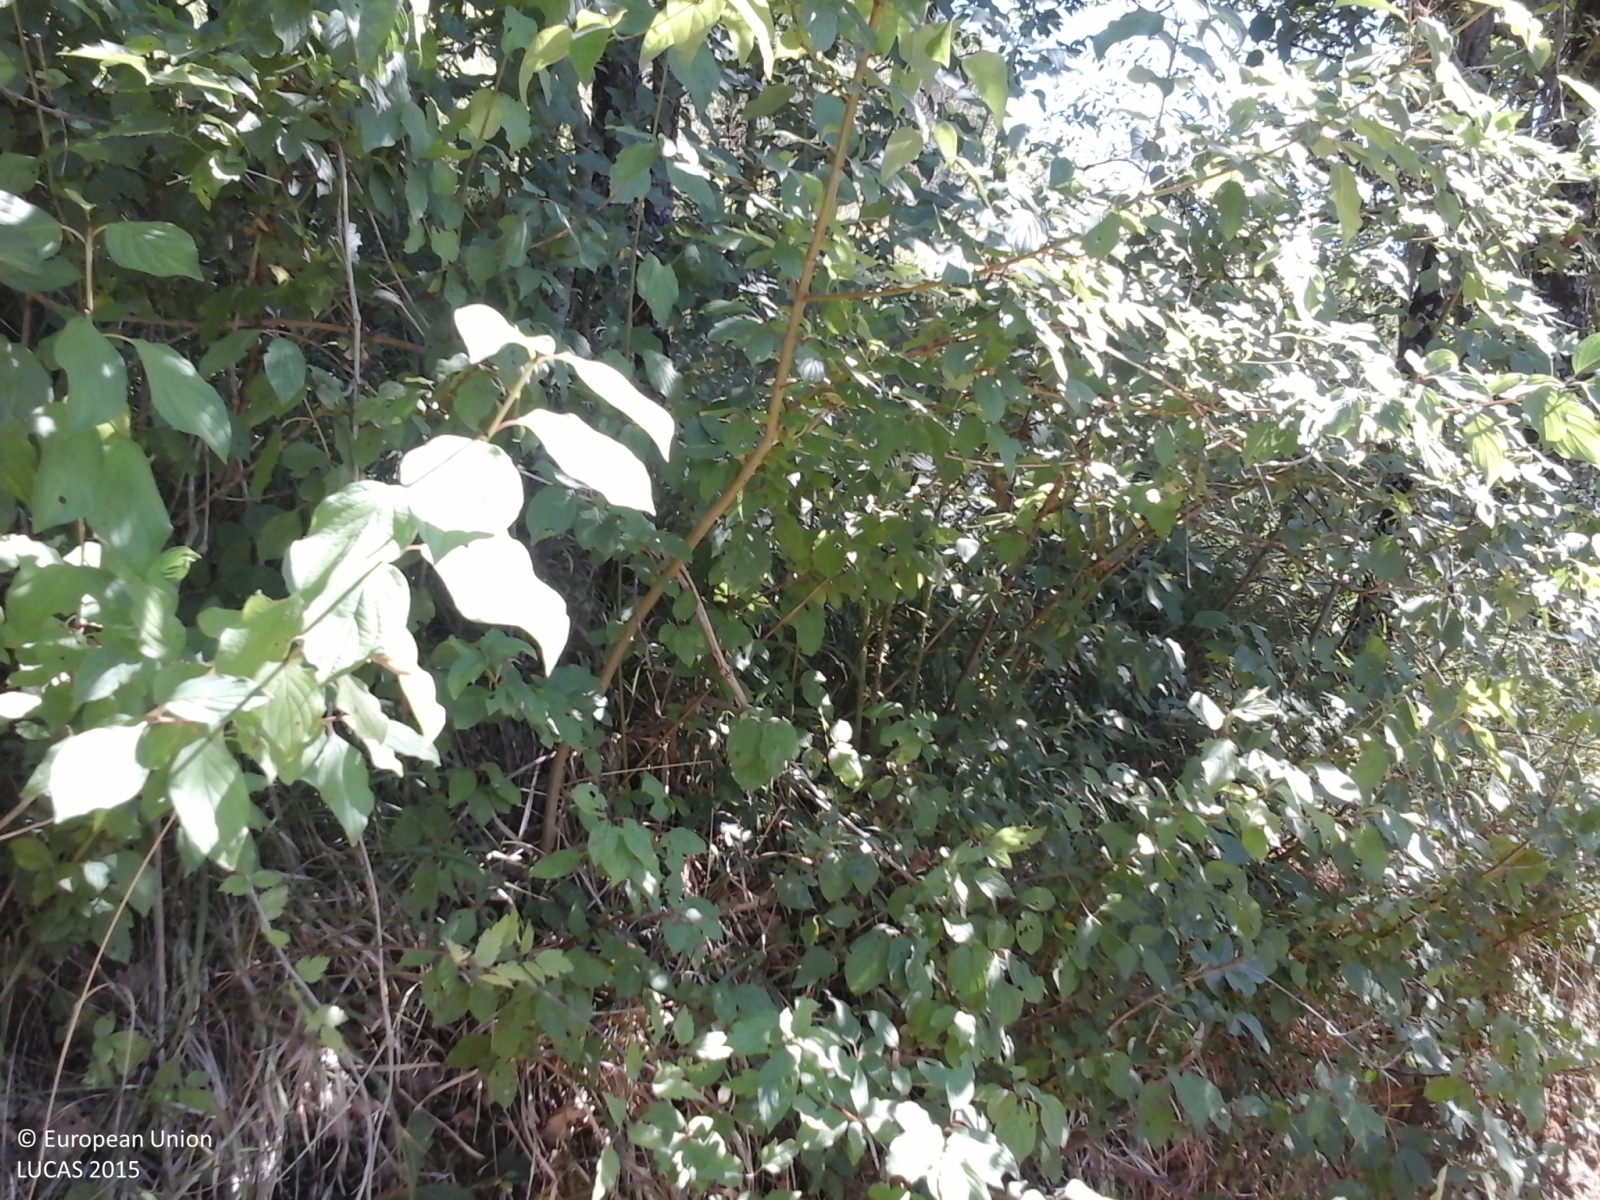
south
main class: Woodland
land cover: Broadleaved woodland
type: thermophilous deciduous forest
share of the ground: > 75 %
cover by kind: broadleaved forest trees 100 %
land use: Forestry
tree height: > 5 m
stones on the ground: < 10 %
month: August
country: IT
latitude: 43.5471
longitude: 12.3826
